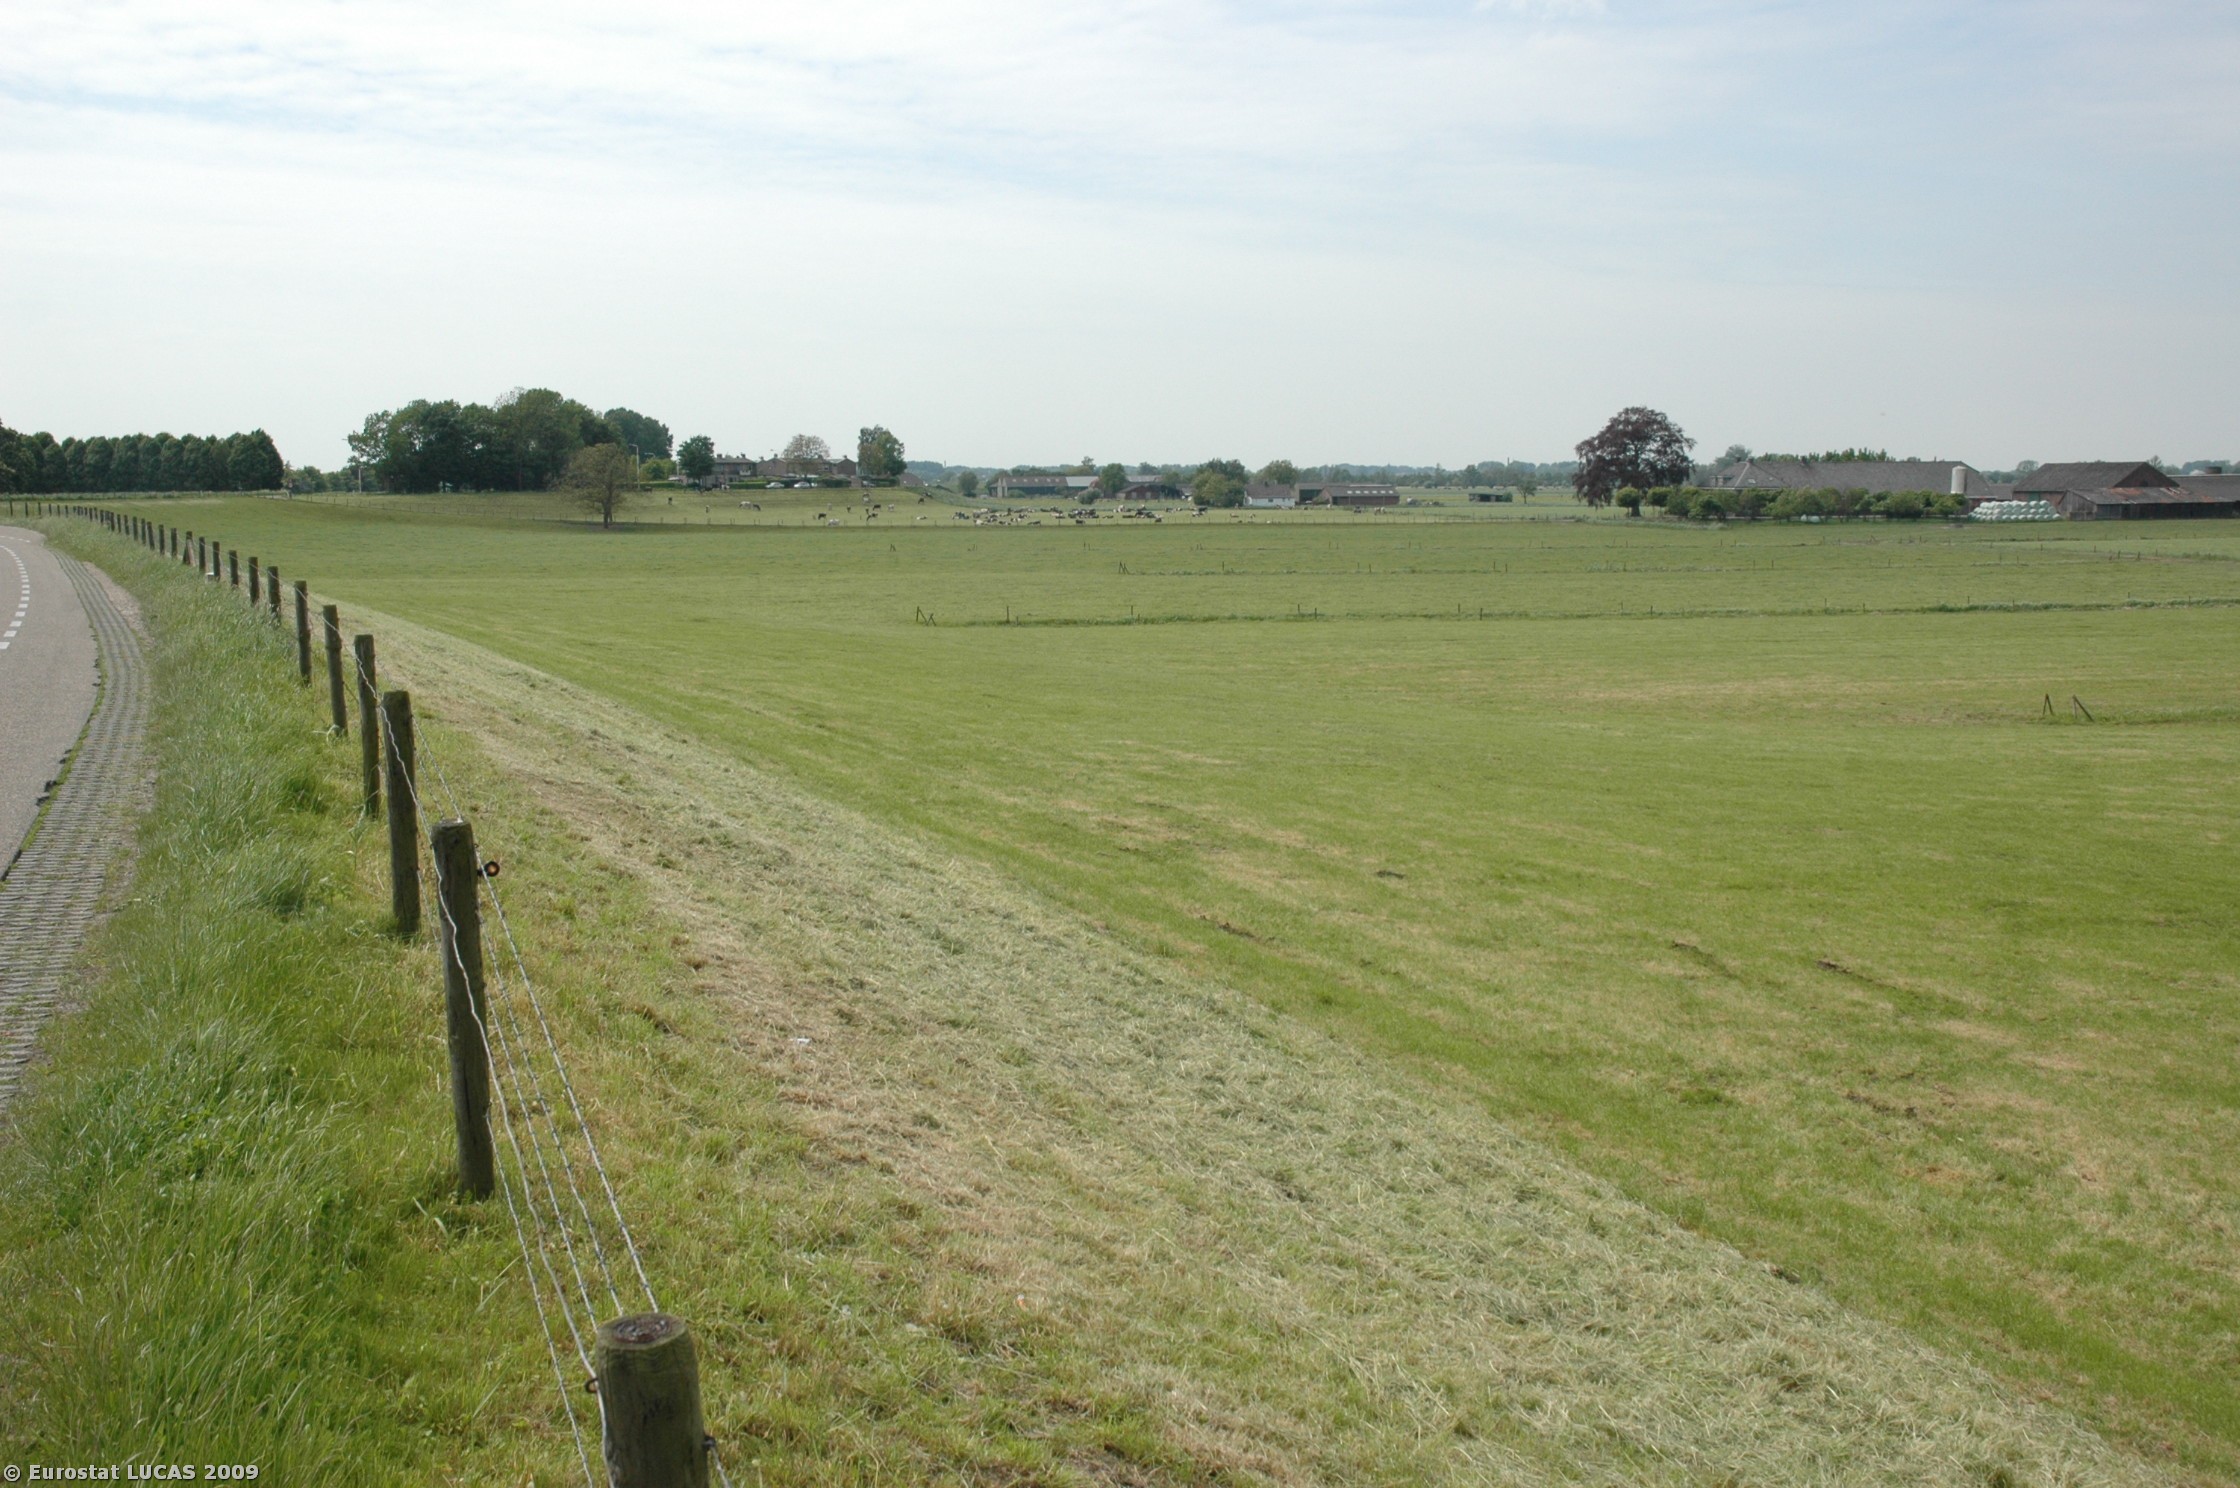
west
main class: Grassland
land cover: Grassland without tree/shrub cover
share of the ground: > 75 %
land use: Agriculture (excluding fallow land and kitchen gardens)
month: May
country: NL
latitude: 51.9828
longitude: 5.4116
